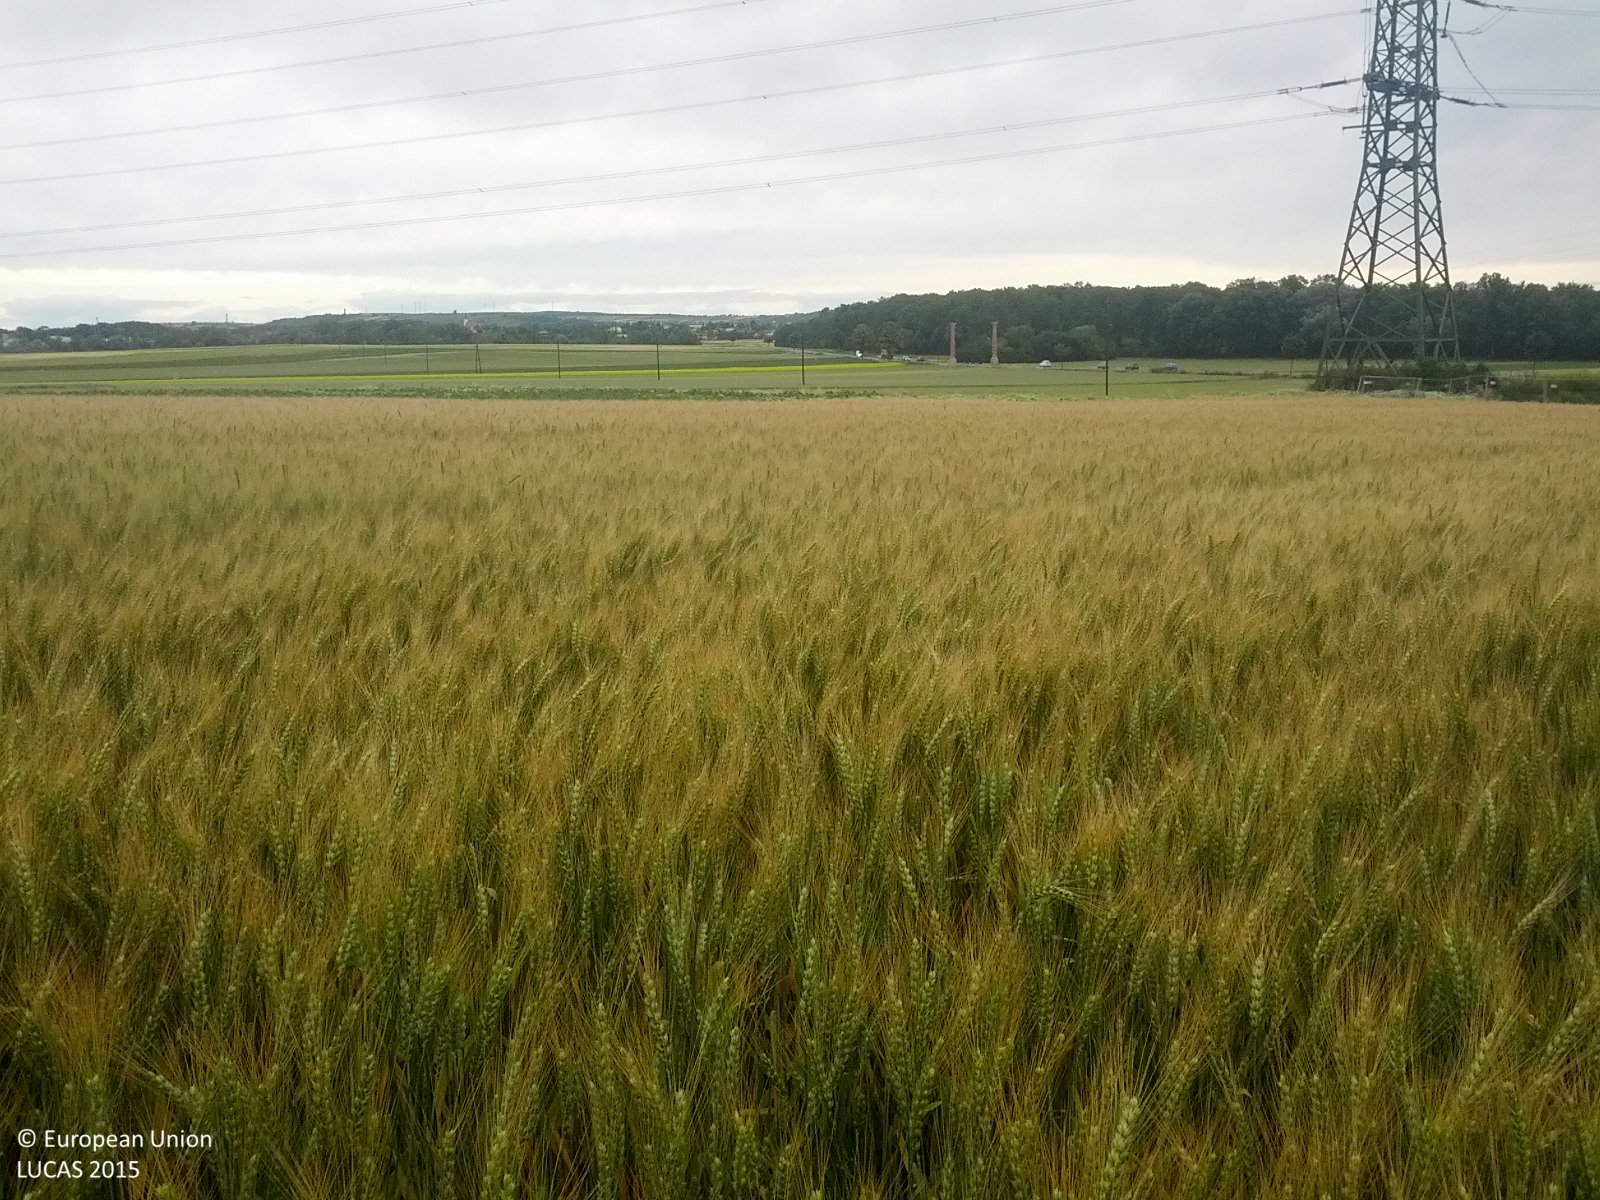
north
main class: Cropland
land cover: Common wheat
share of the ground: > 75 %
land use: Agriculture (excluding fallow land and kitchen gardens)
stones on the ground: 25 - 50 %
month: June
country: AT
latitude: 48.3439
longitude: 16.7123
